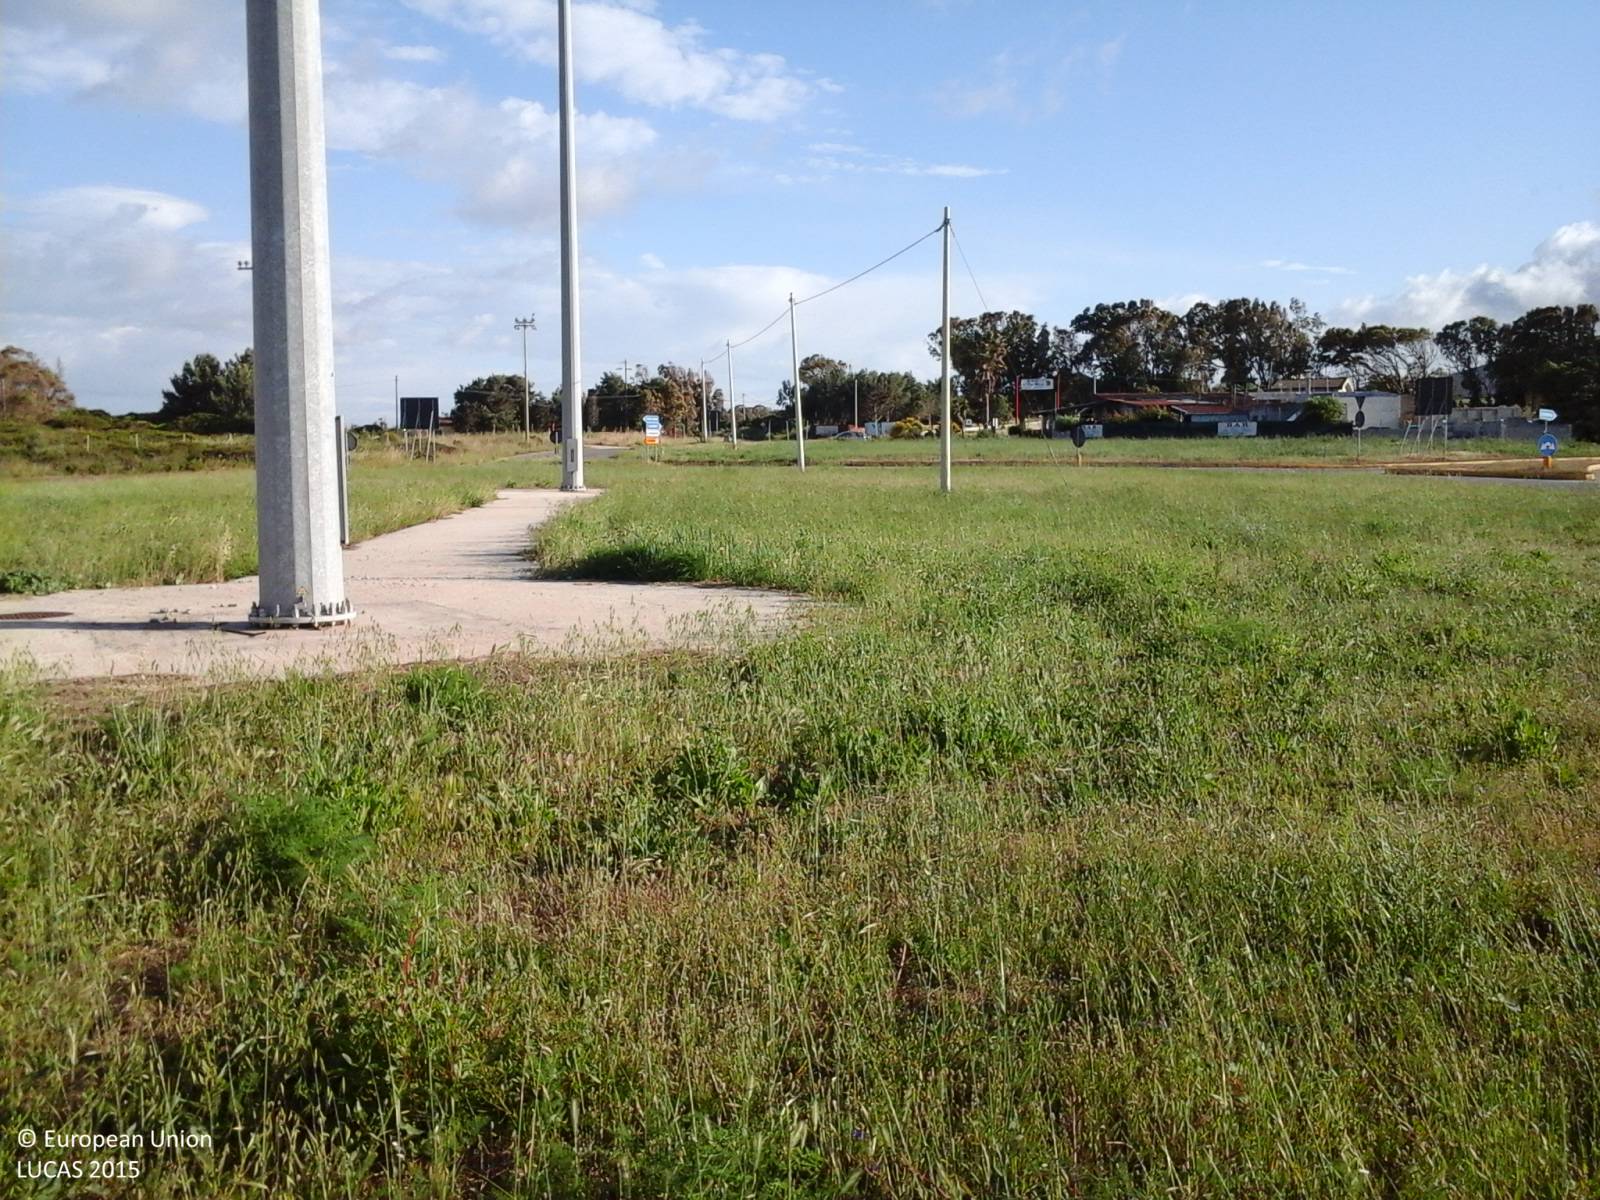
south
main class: Grassland
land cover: Grassland without tree/shrub cover
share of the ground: > 75 %
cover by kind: herbaceous plants 100 %
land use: Road transport
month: May
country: IT
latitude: 40.8147
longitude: 8.3598
